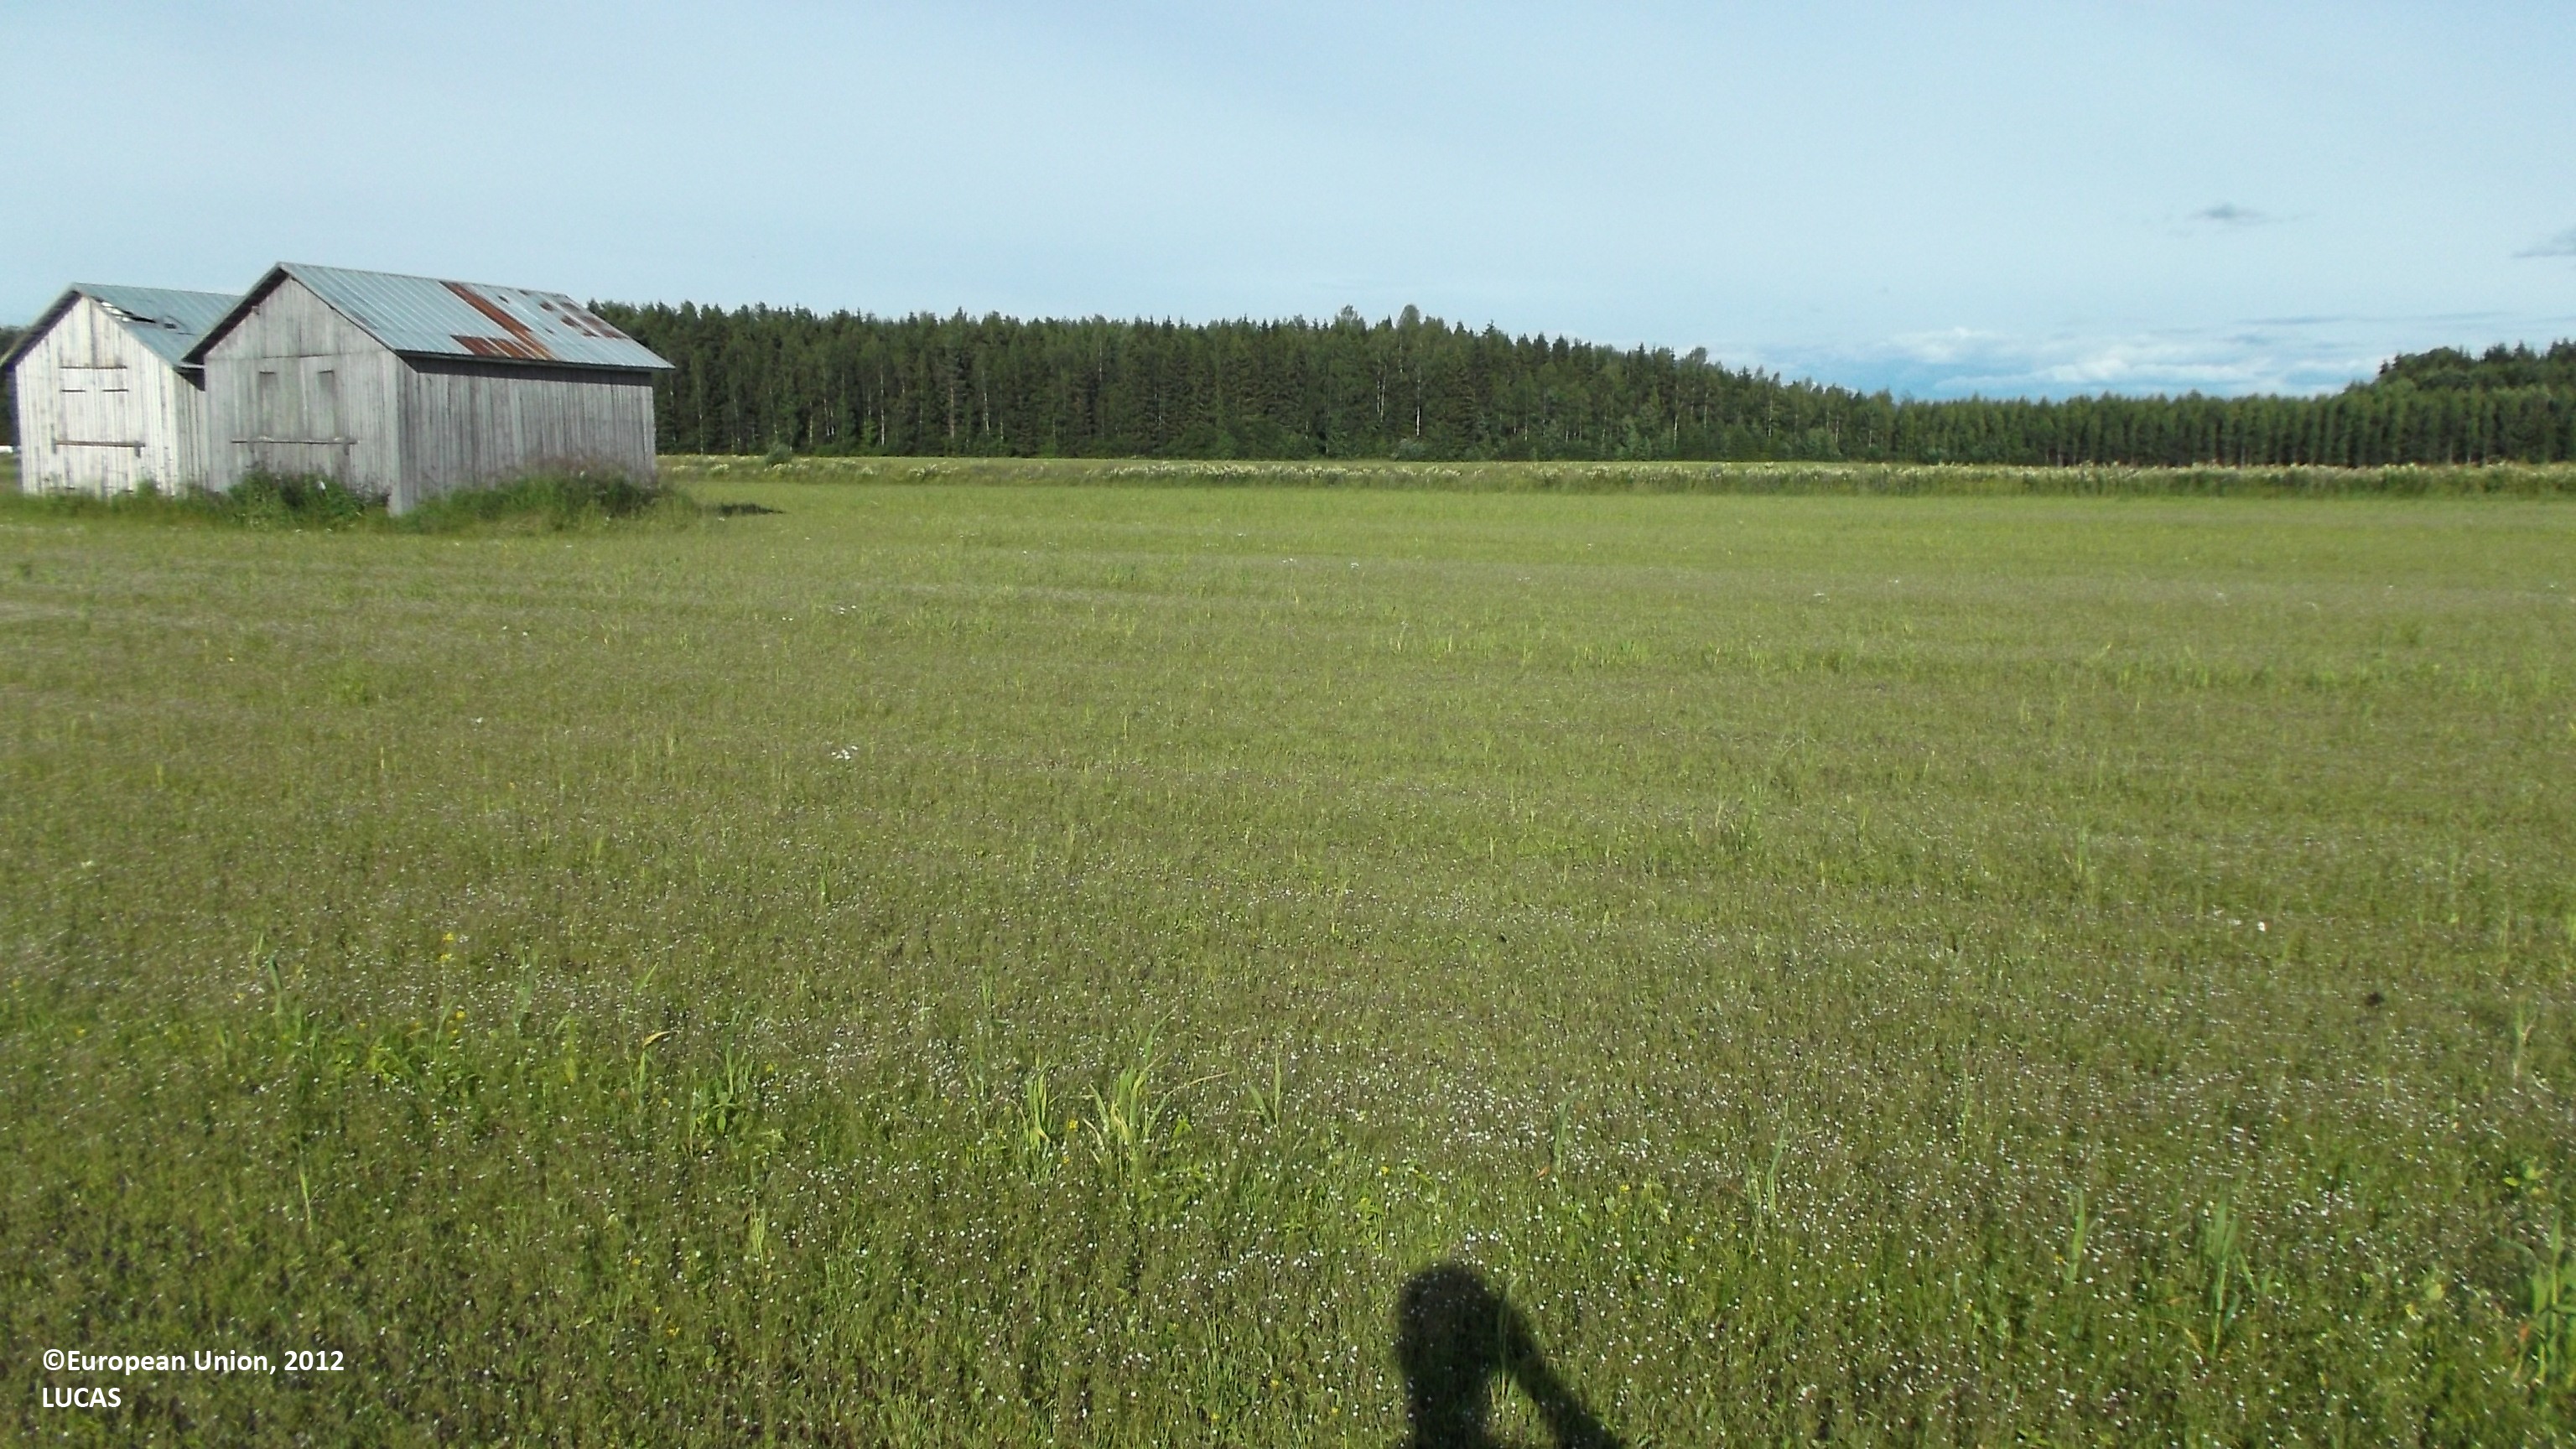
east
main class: Cropland
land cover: Other non-permanent industrial crops
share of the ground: < 10 %
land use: Agriculture (excluding fallow land and kitchen gardens)
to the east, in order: Other non-permanent industrial crops; Grass margins; Ditches and canals; Temporary grasslands; Ditches and canals; Oats
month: July
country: FI
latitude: 63.2413
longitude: 23.7859
